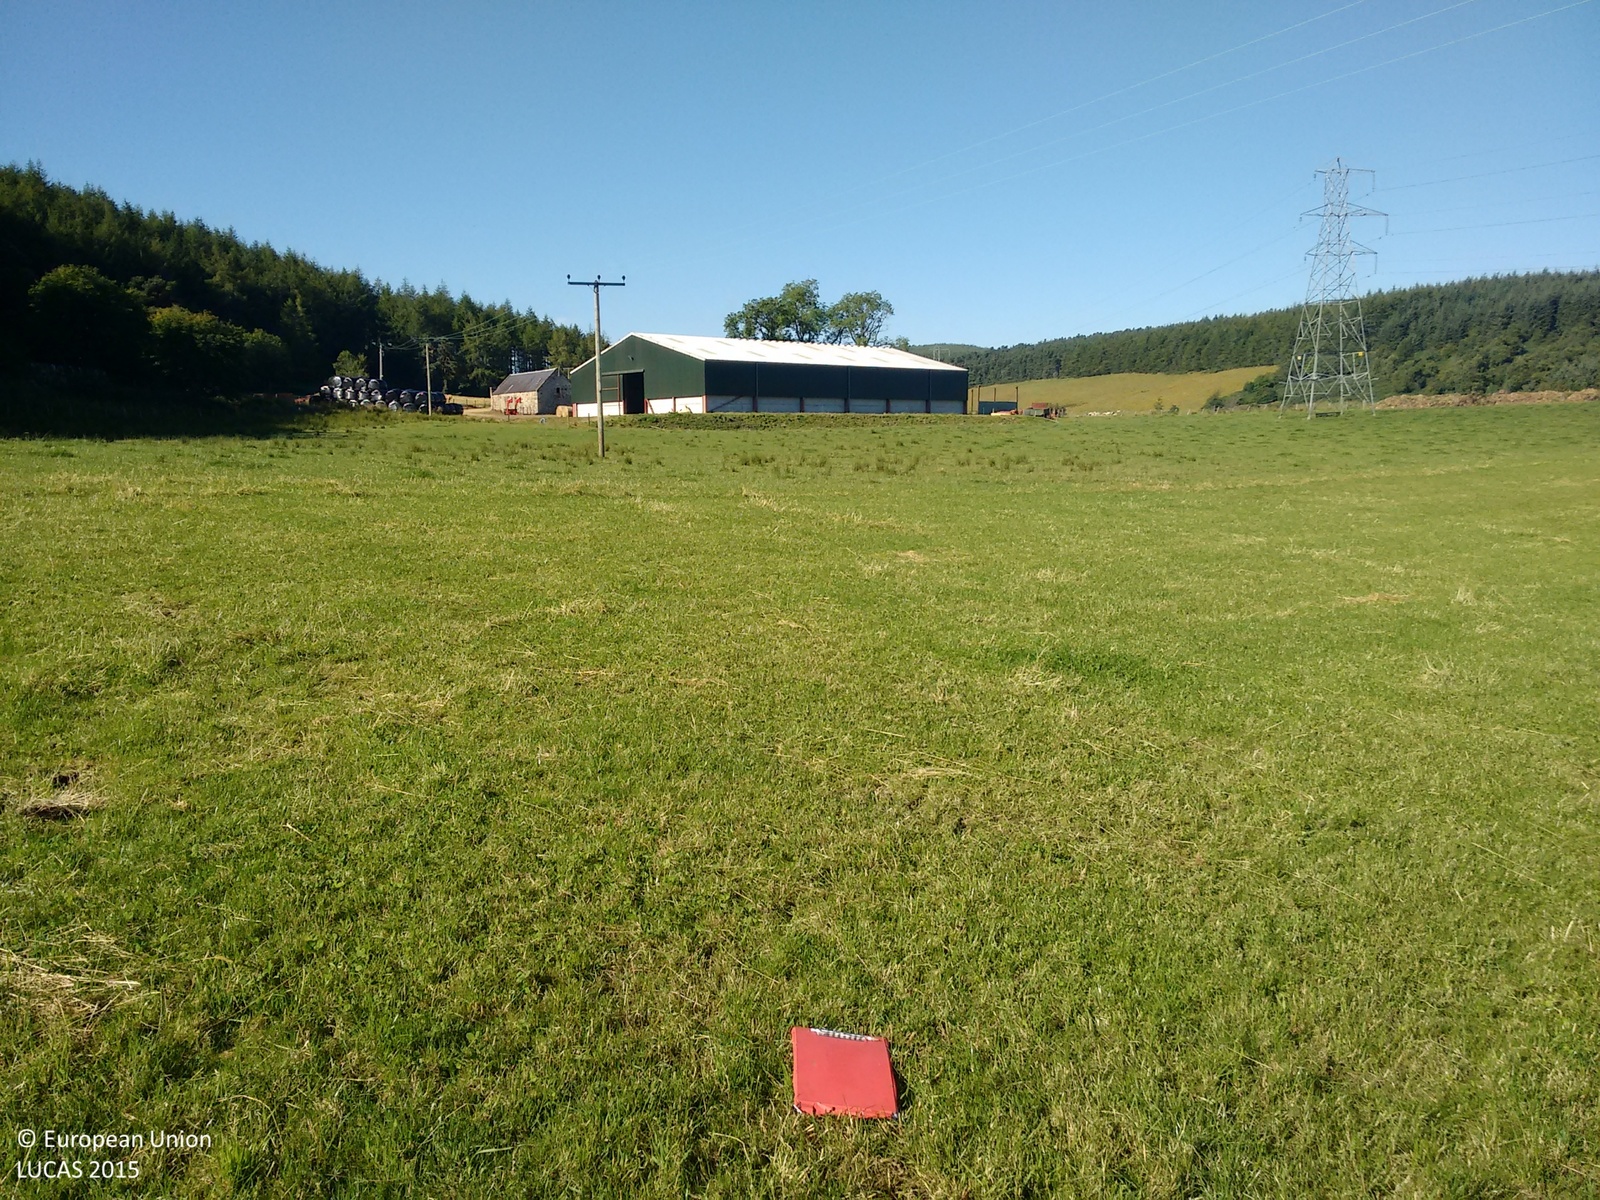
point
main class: Grassland
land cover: Grassland without tree/shrub cover
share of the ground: > 75 %
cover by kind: herbaceous plants 100 %
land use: Agriculture (excluding fallow land and kitchen gardens)
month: August
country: GB
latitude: 57.4700
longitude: -3.0509
